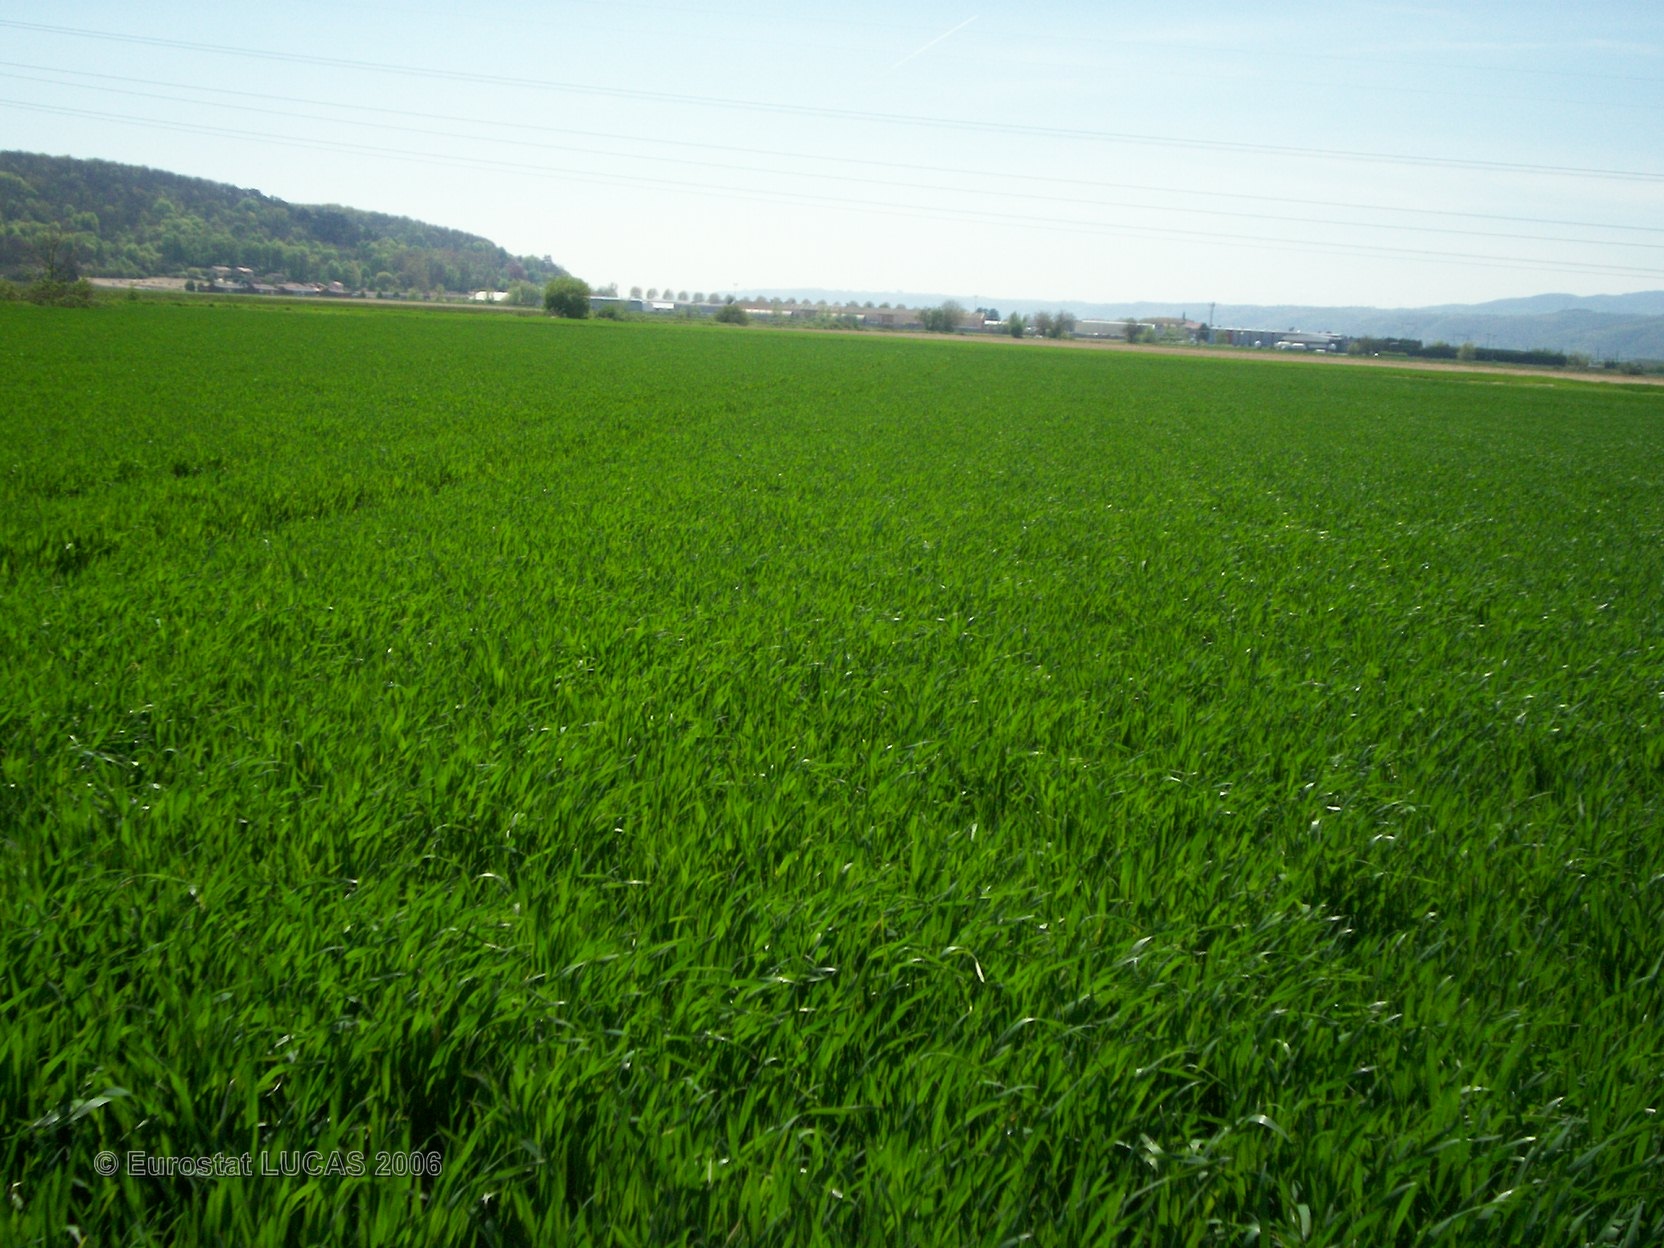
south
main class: Cropland
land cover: Triticale
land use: Agriculture (excluding fallow land and kitchen gardens)
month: April
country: FR
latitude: 45.4113
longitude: 4.7783
